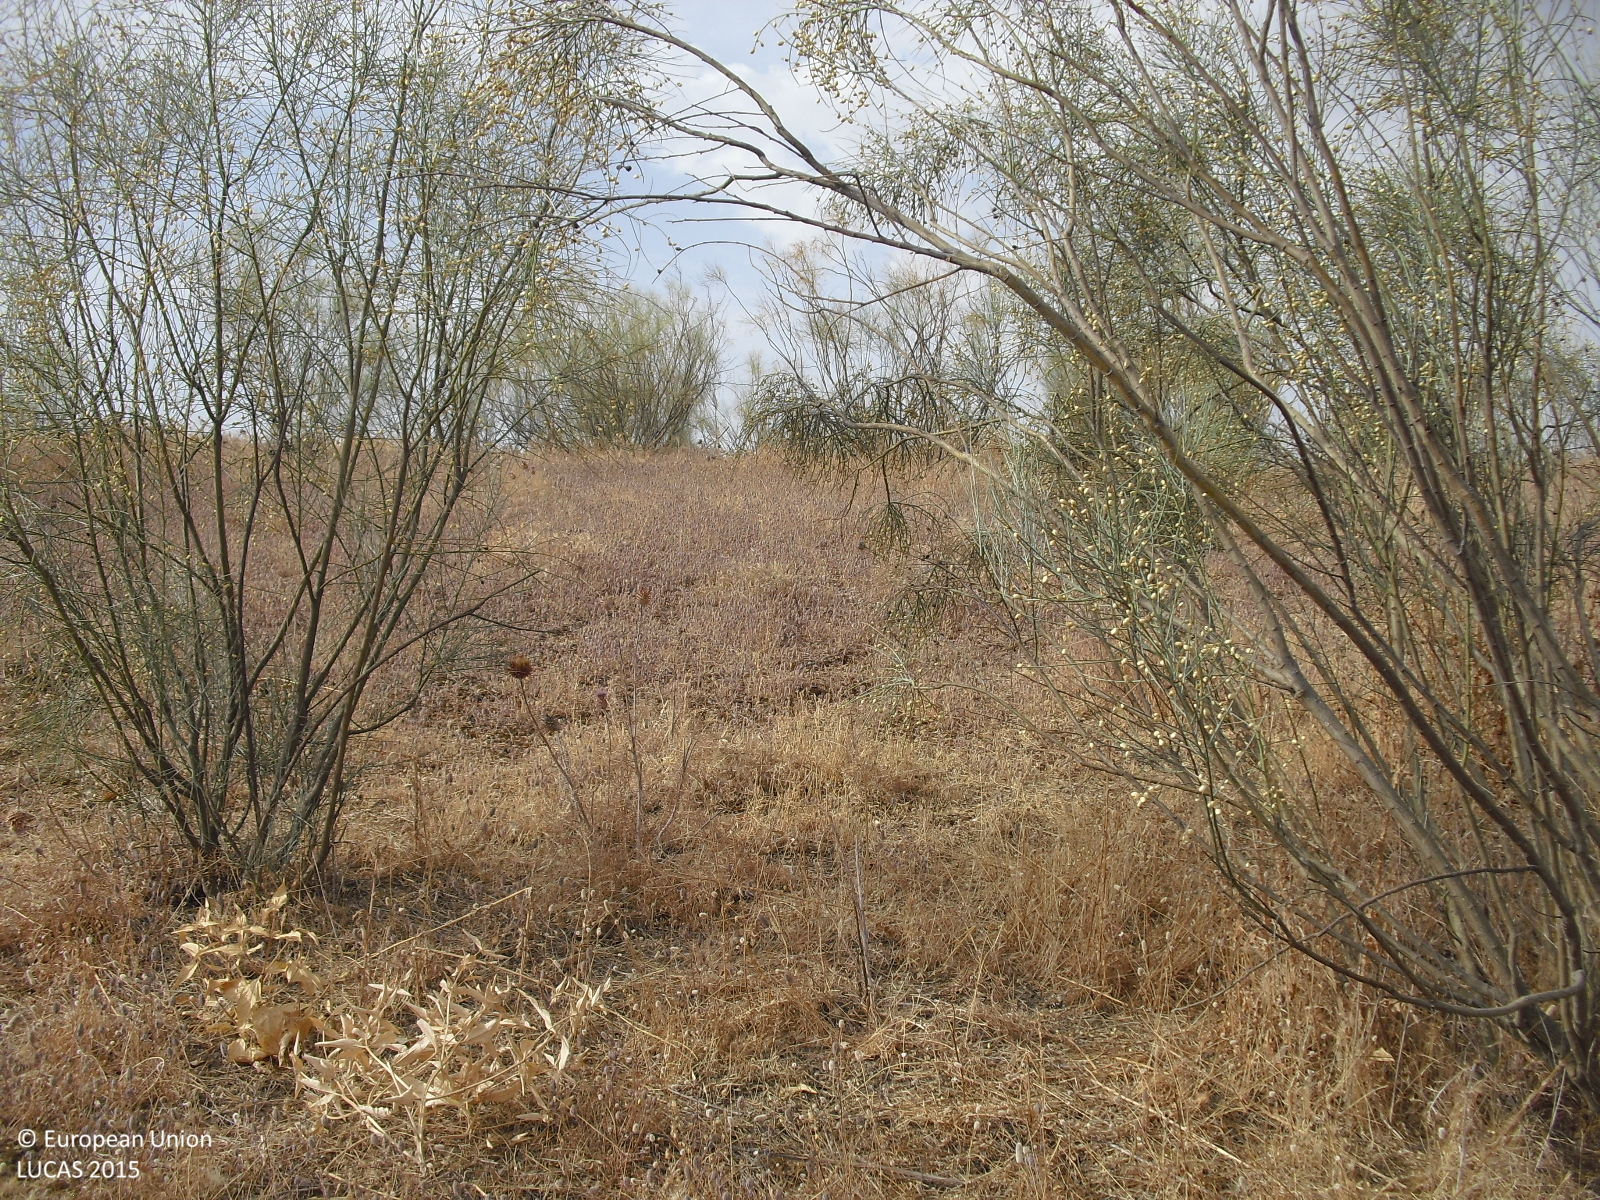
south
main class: Shrubland
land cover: Shrubland without tree cover
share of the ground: 10 - 25 %
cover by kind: herbaceous plants 75 %, shrubs 15 %, unconsolidated bare surface 10 %
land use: Semi-natural and natural areas not in use
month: August
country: ES
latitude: 37.3205
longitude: -4.4334
